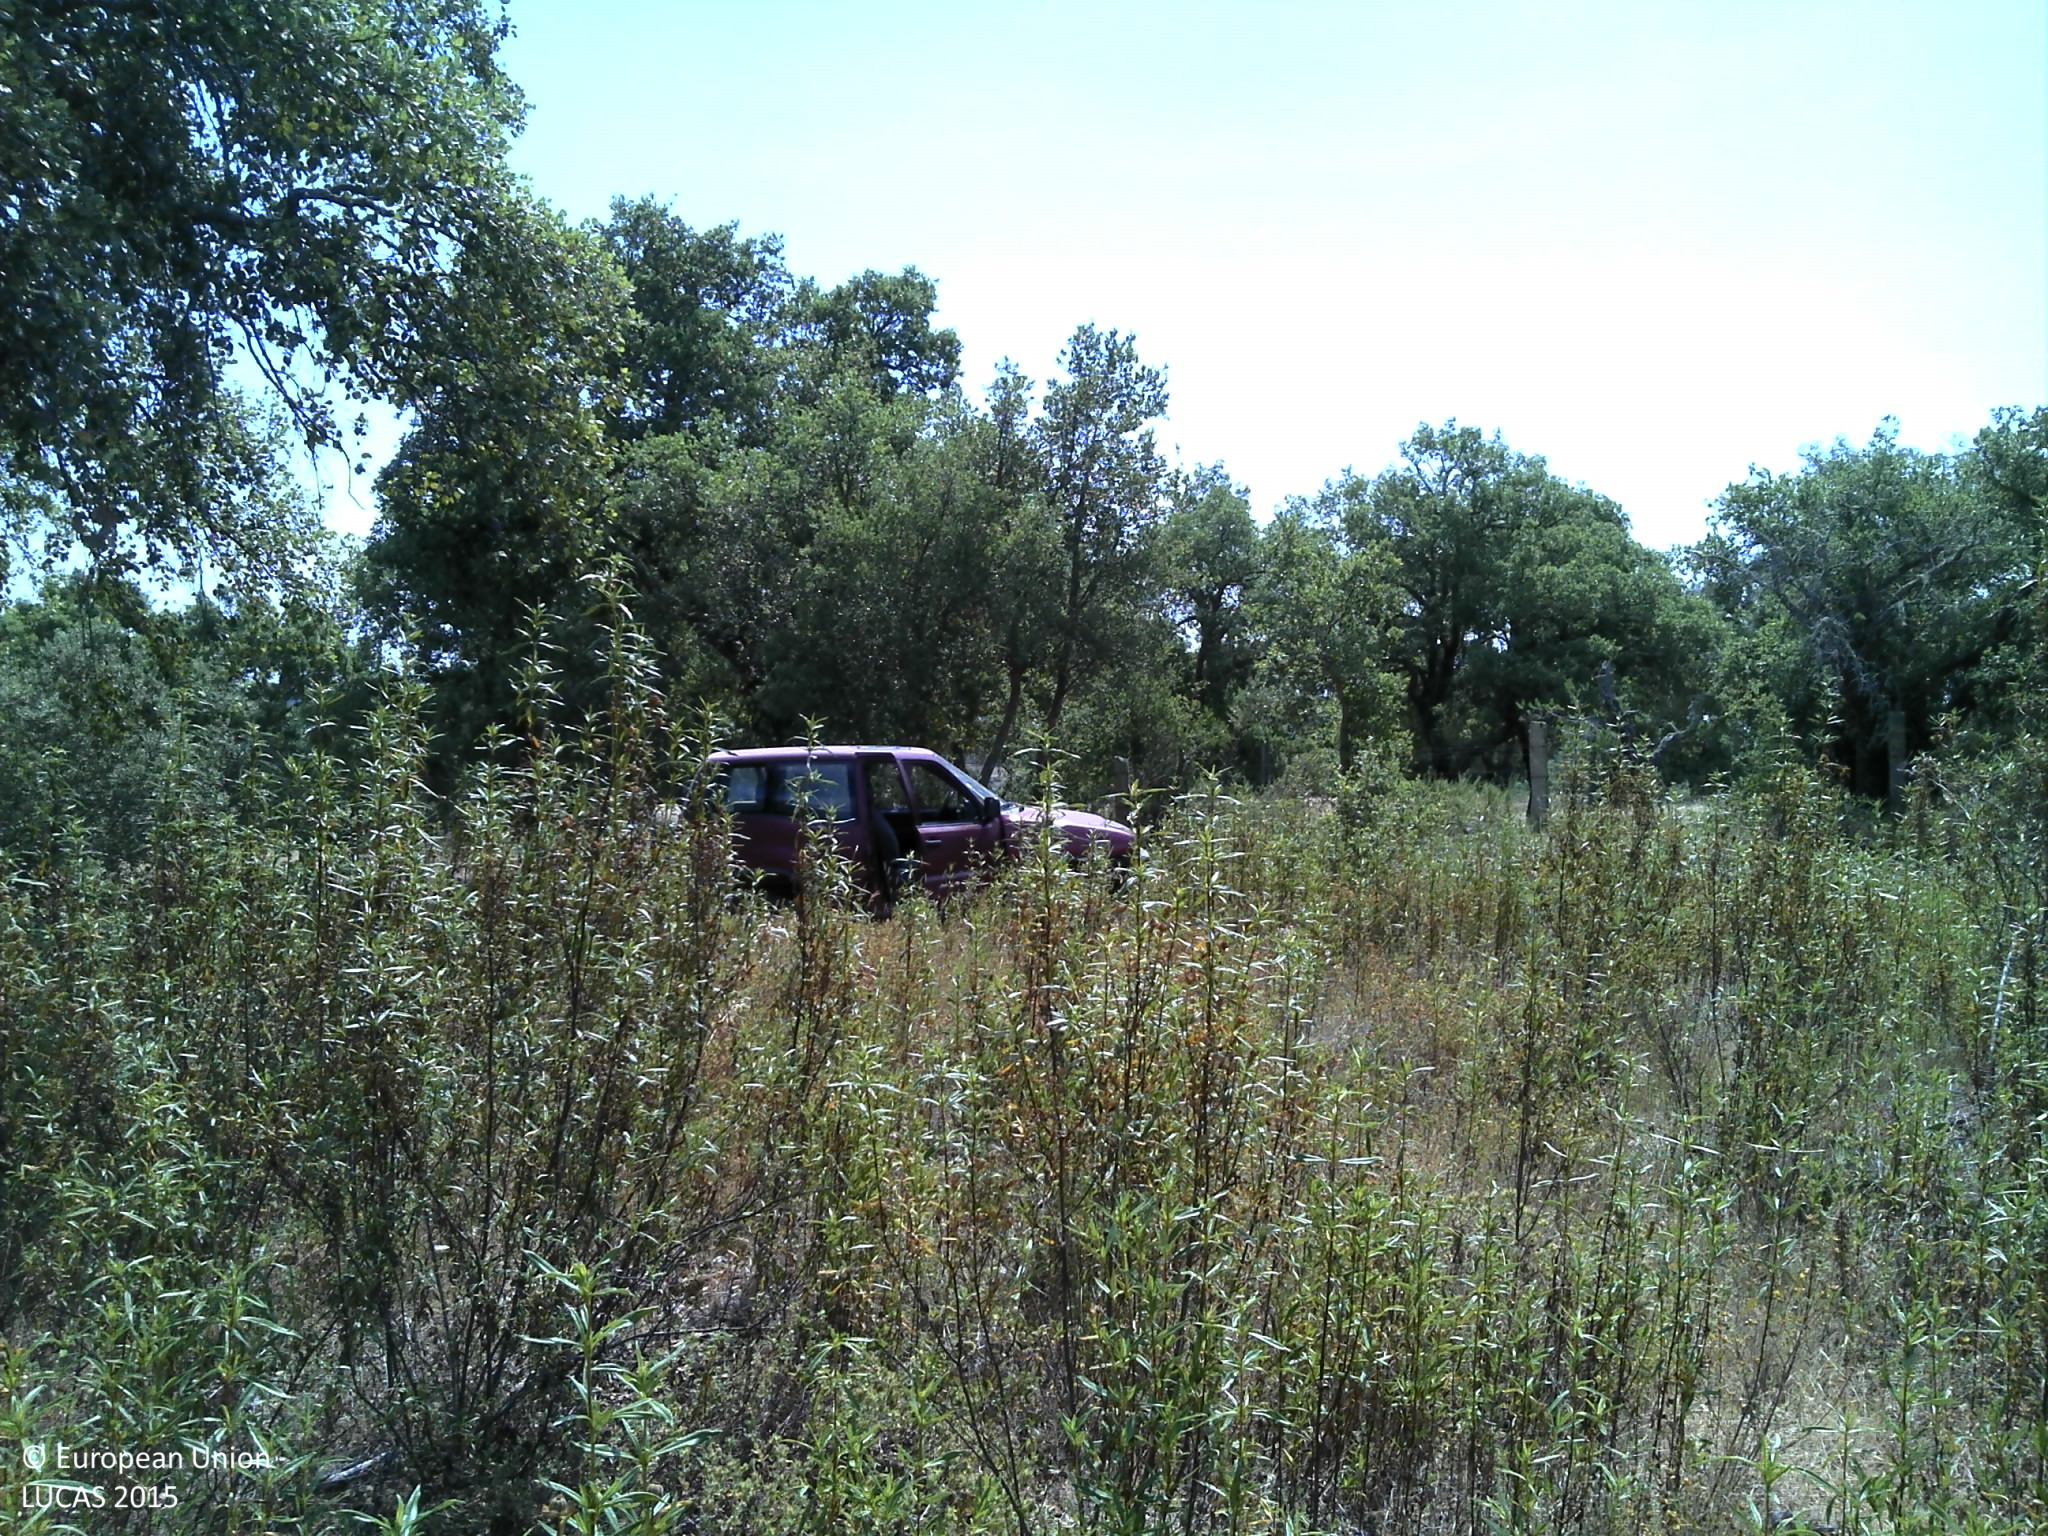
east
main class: Woodland
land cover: Broadleaved woodland
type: broadleaved evergreen forest
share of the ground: 10 - 25 %
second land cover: Shrubland without tree cover
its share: > 75 %
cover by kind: shrubs 75 %, broadleaved forest trees 20 %, herbaceous plants 5 %
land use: Forestry
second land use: Agriculture (excluding fallow land and kitchen gardens)
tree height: > 5 m
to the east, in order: Broadleaved woodland; Shrubland without tree cover; Broadleaved woodland; Other bare soil; Shruby margins; Fences; Shruby margins; Fences; Broadleaved woodland; Tracks; Fences; Broadleaved woodland; Grassland without tree/shrub cover
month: May
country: PT
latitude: 38.8913
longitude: -7.8567
